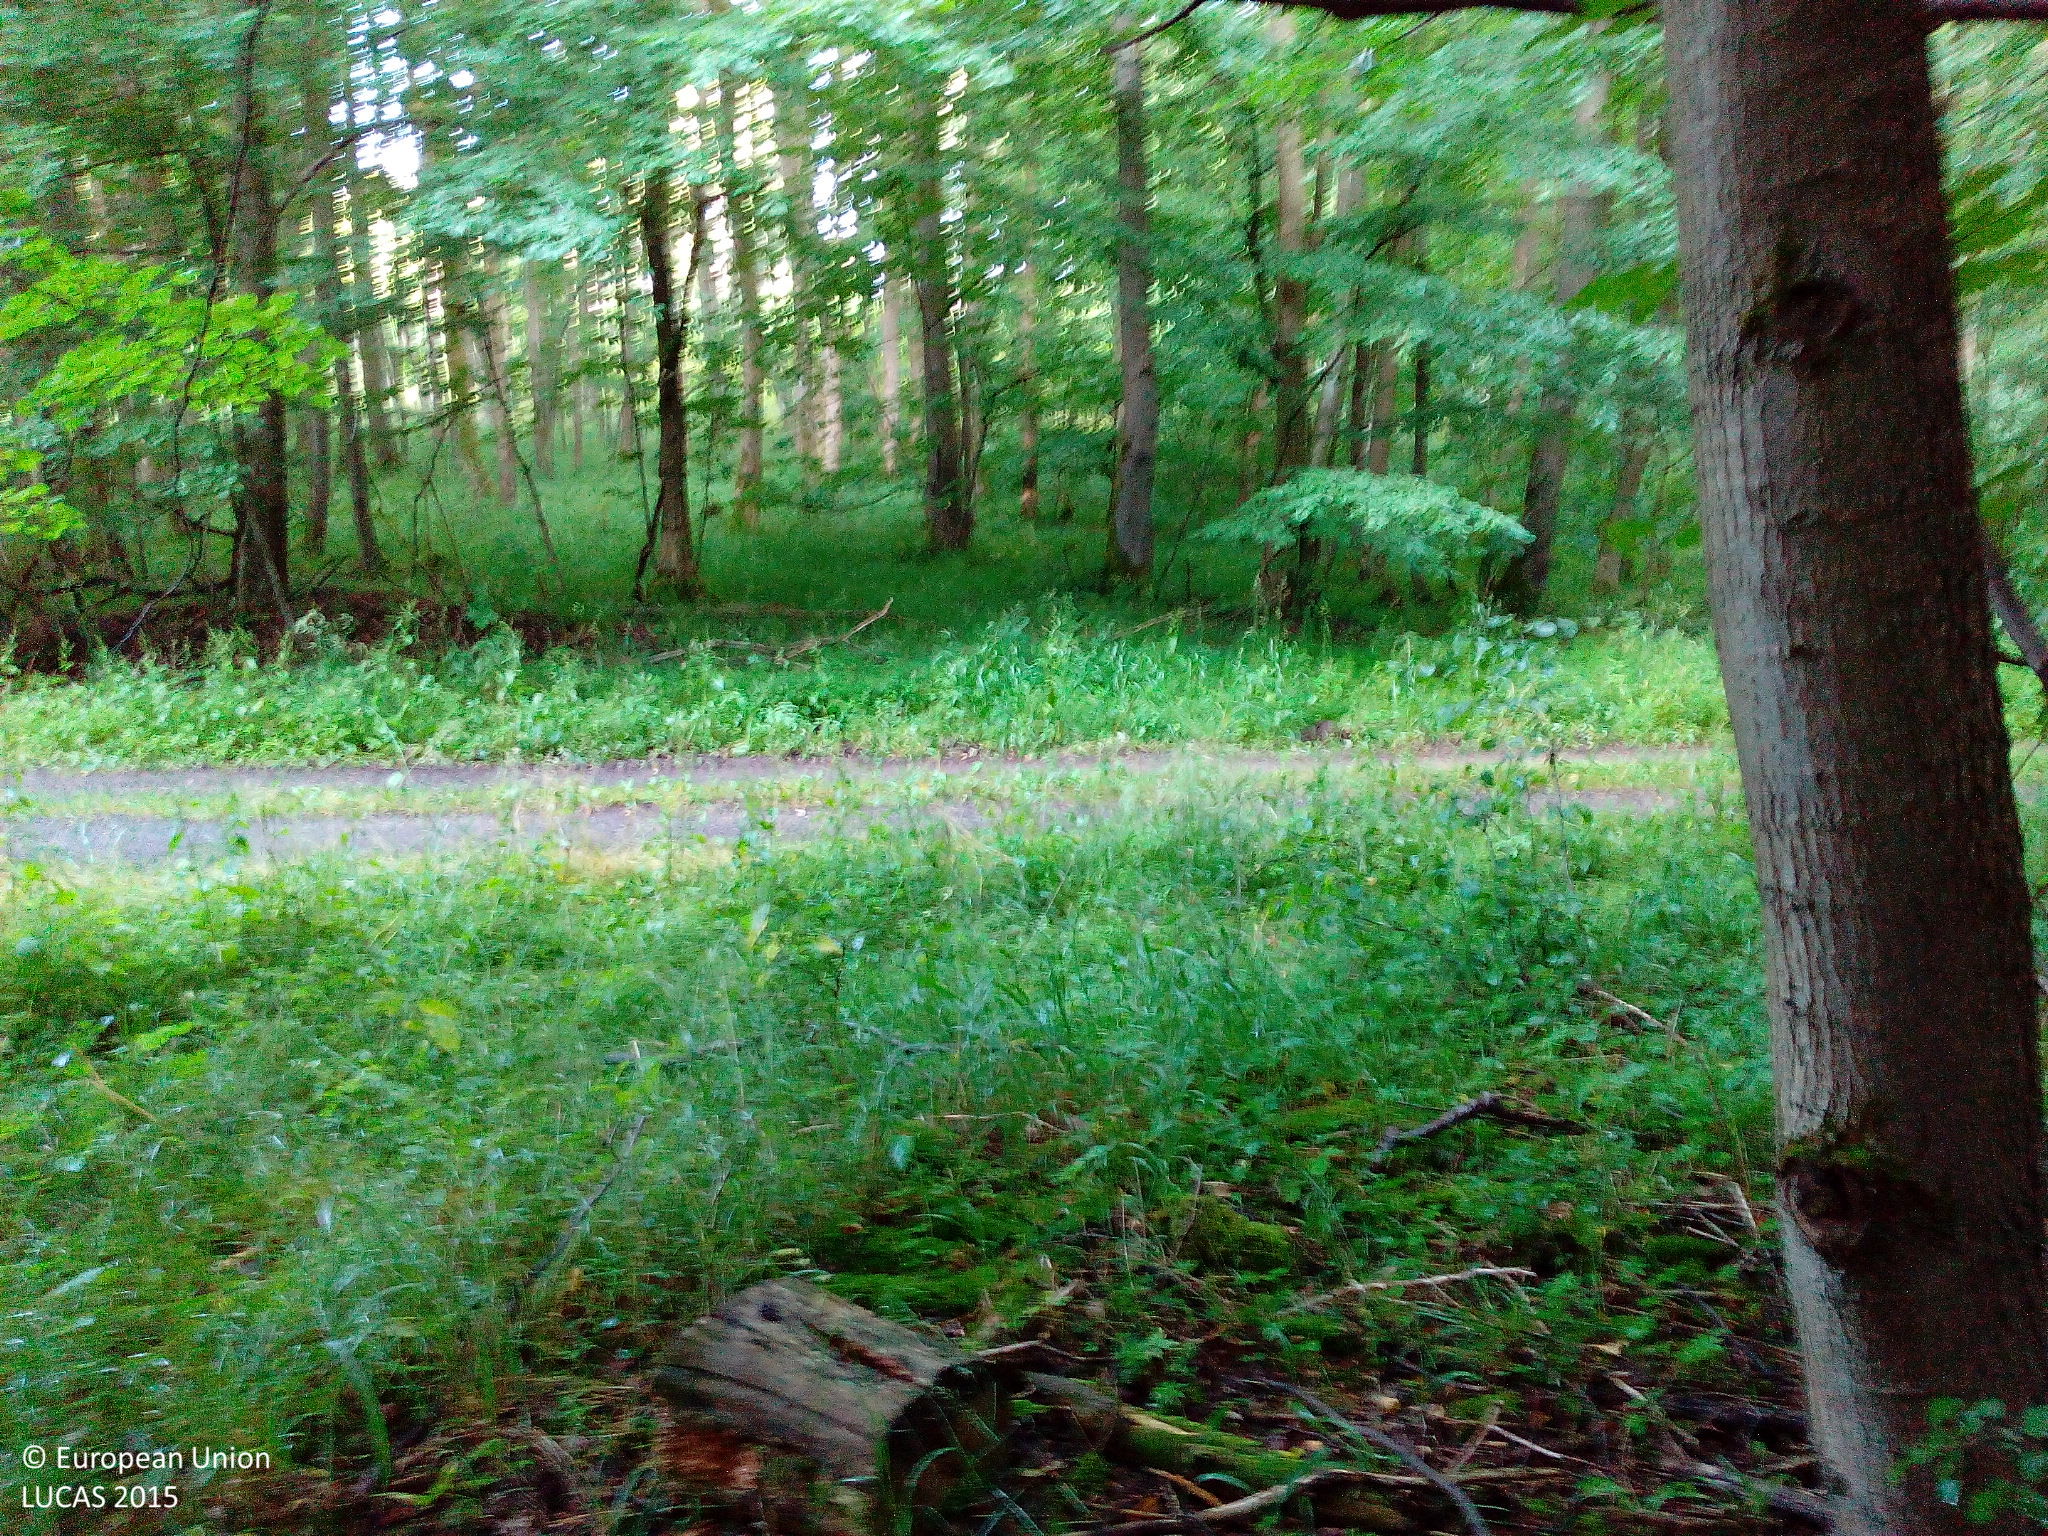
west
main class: Woodland
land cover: Broadleaved woodland
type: acidophilous oak and oak-birch forest
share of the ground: > 75 %
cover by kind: broadleaved forest trees 100 %
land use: Forestry
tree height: > 5 m
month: July
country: DE
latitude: 50.6696
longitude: 9.8727
